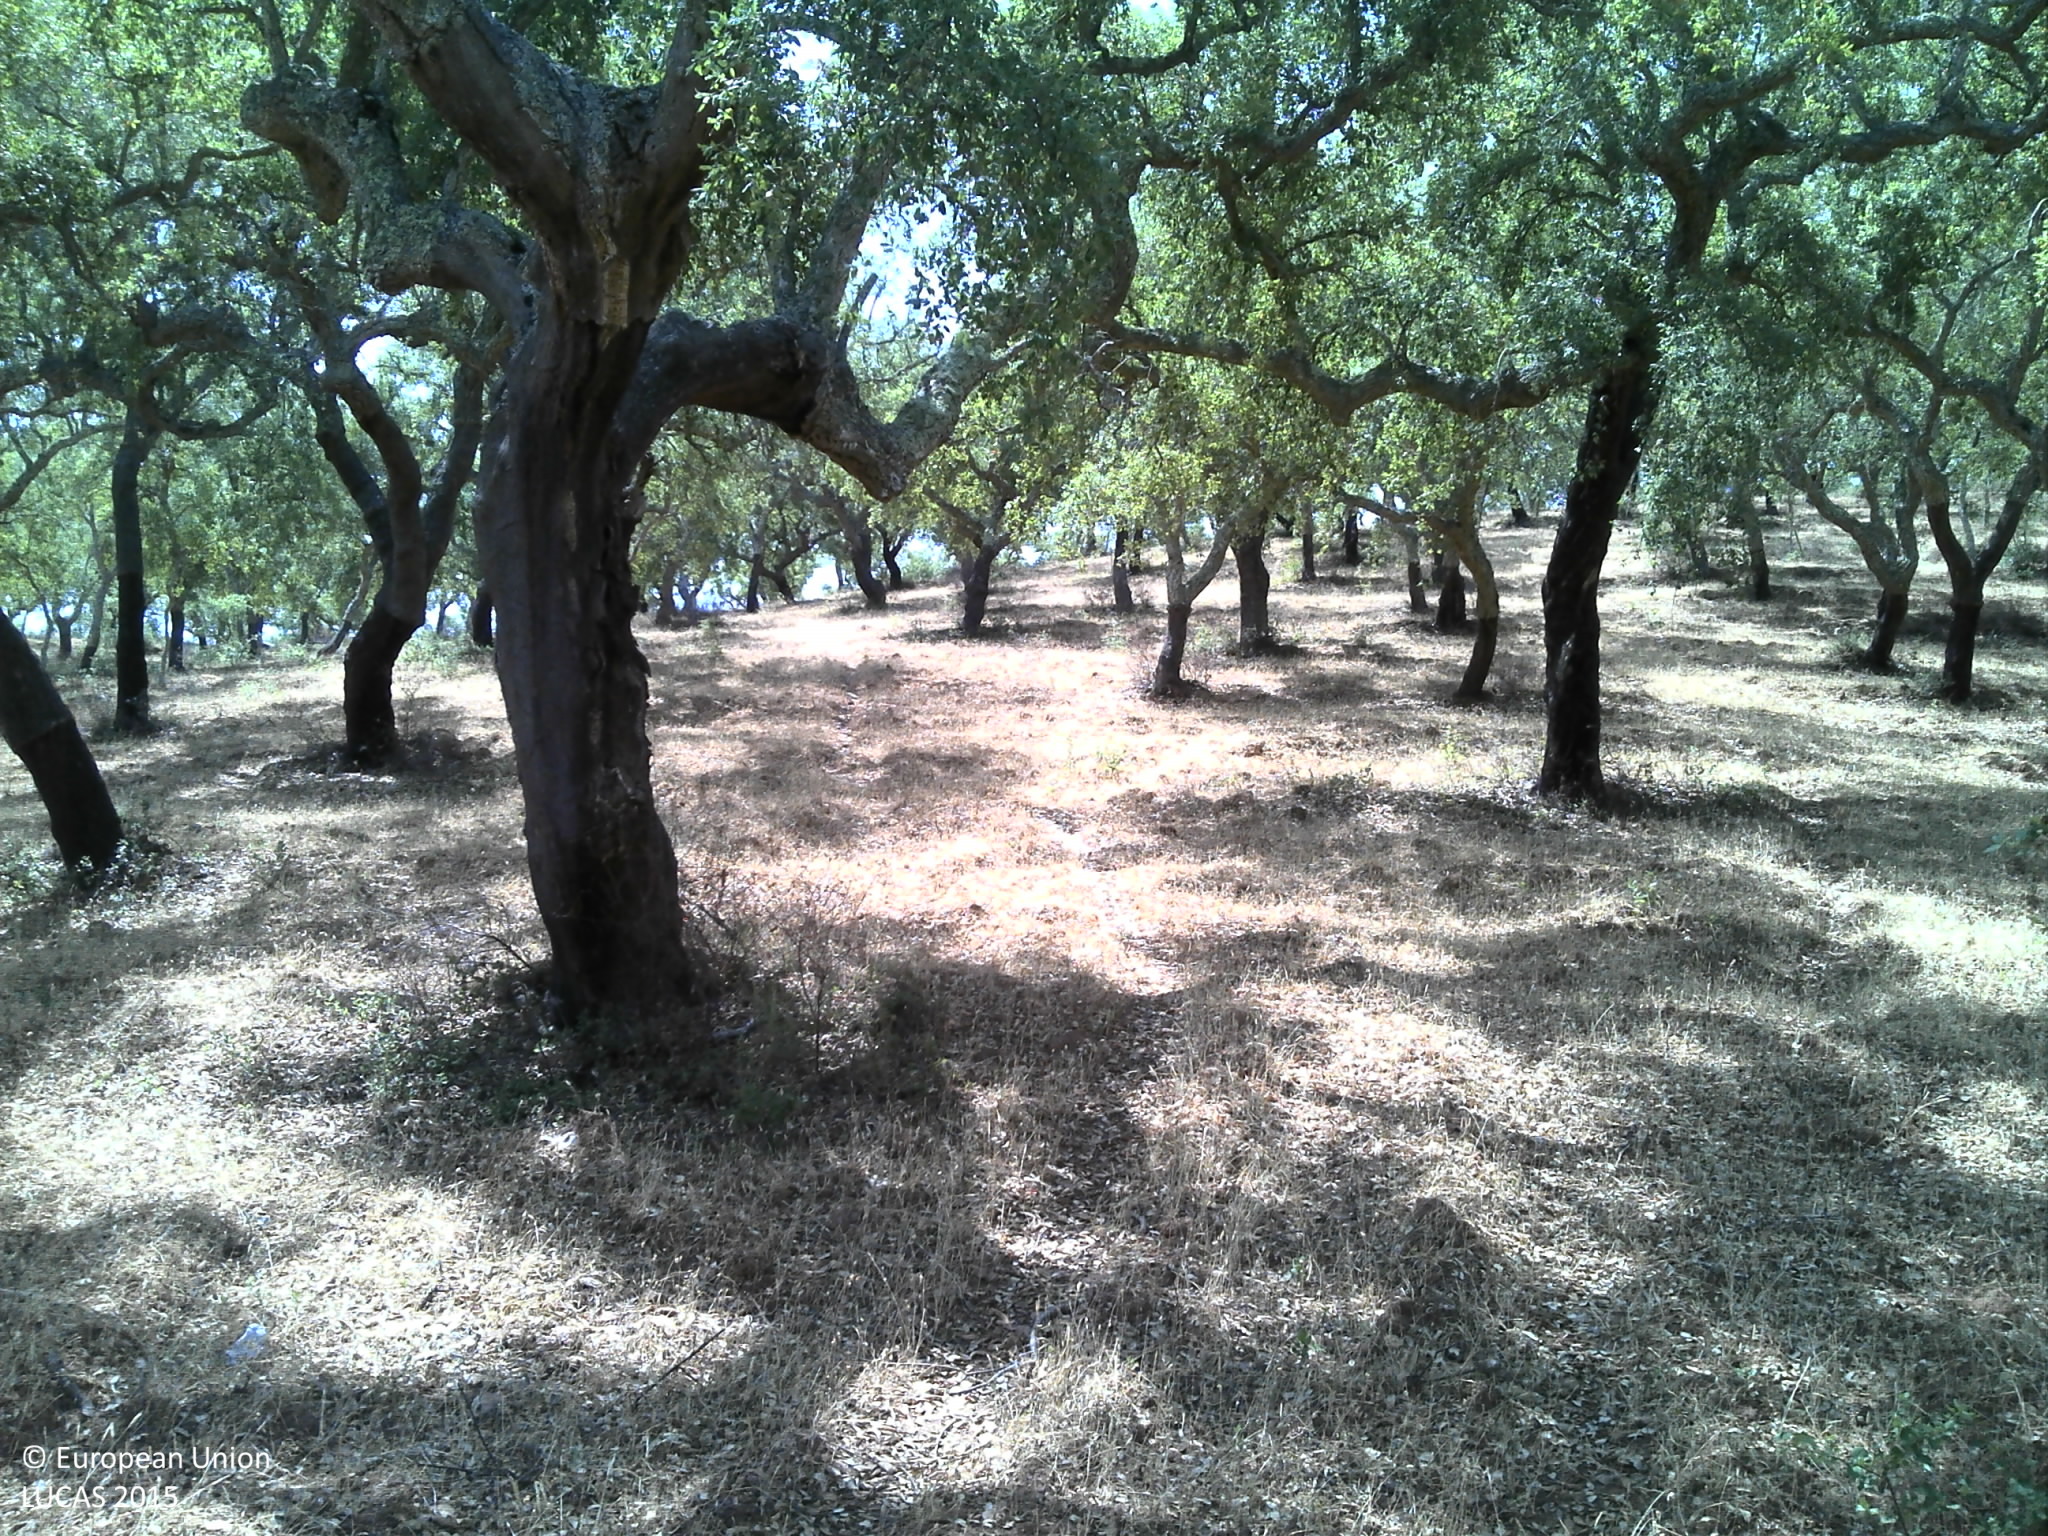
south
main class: Woodland
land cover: Broadleaved woodland
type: broadleaved evergreen forest
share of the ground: > 75 %
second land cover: Grassland without tree/shrub cover
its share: 25 - 50 %
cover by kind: broadleaved forest trees 75 %, herbaceous plants 20 %, shrubs 5 %
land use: Forestry
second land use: Agriculture (excluding fallow land and kitchen gardens)
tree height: > 5 m
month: July
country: PT
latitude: 38.2633
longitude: -7.7564
